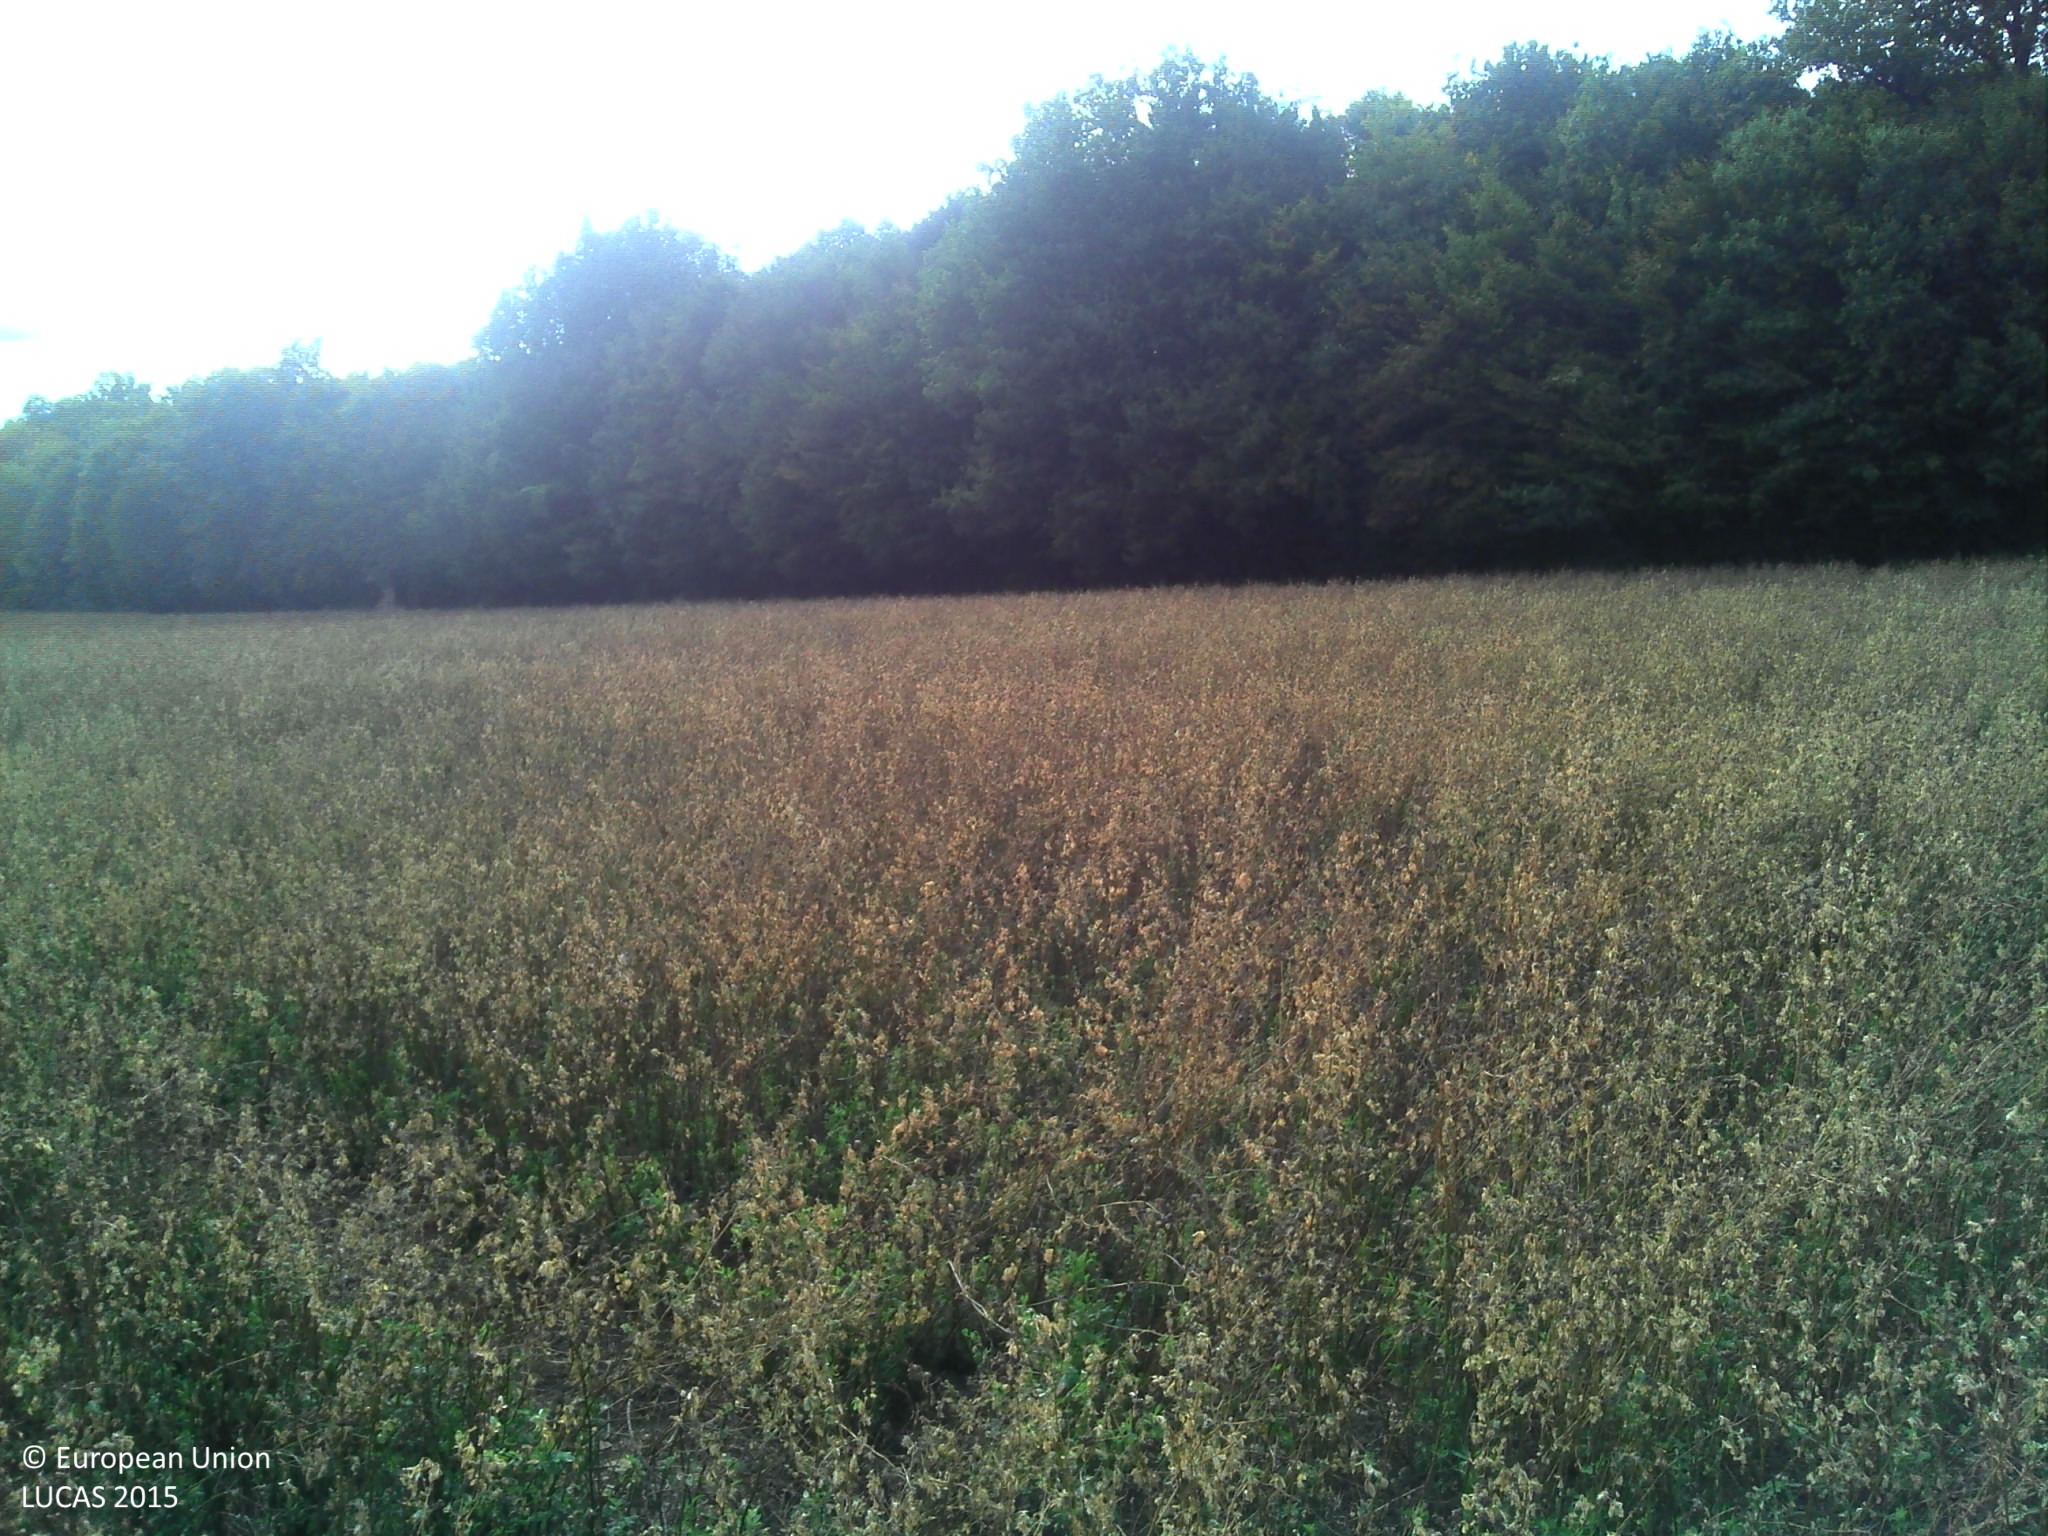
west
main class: Cropland
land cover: Lucerne
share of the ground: > 75 %
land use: Agriculture (excluding fallow land and kitchen gardens)
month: September
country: FR
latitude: 46.8833
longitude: 1.5243
